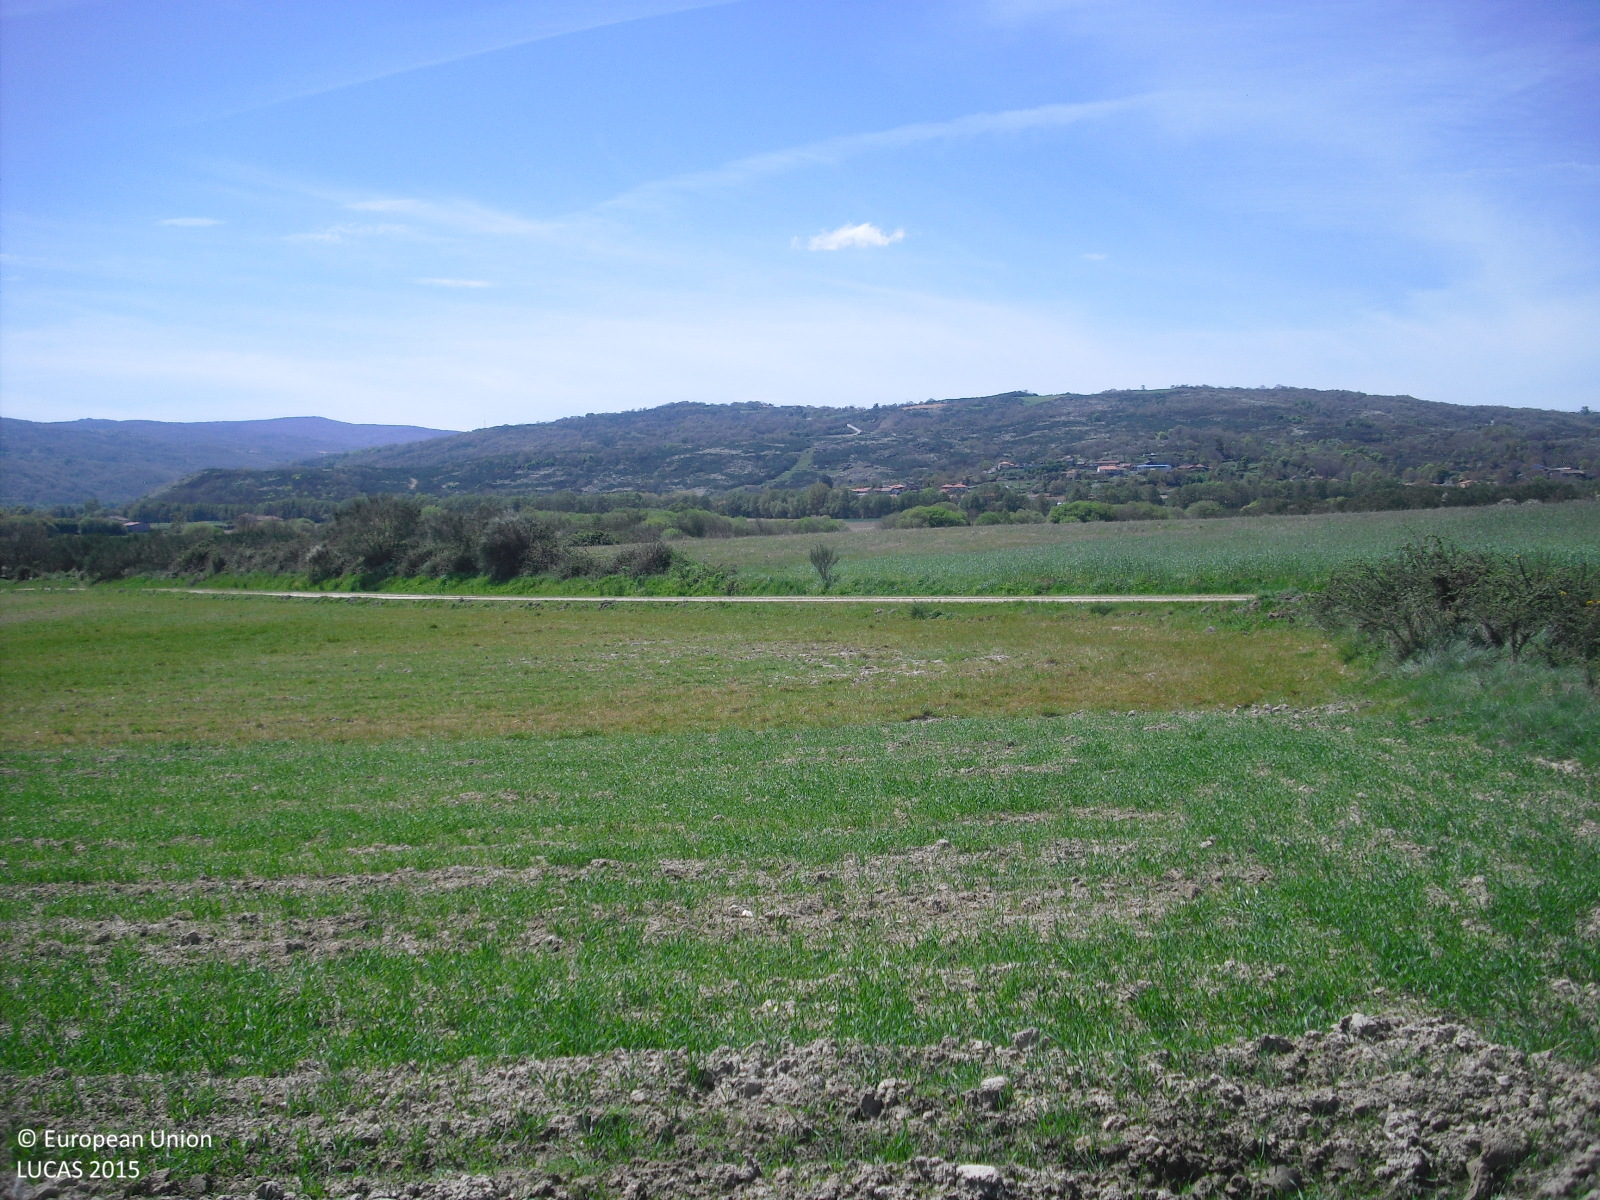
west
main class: Cropland
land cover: Common wheat
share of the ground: 50 - 75 %
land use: Agriculture (excluding fallow land and kitchen gardens)
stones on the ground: < 10 %
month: April
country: ES
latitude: 42.0057
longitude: -7.6832
